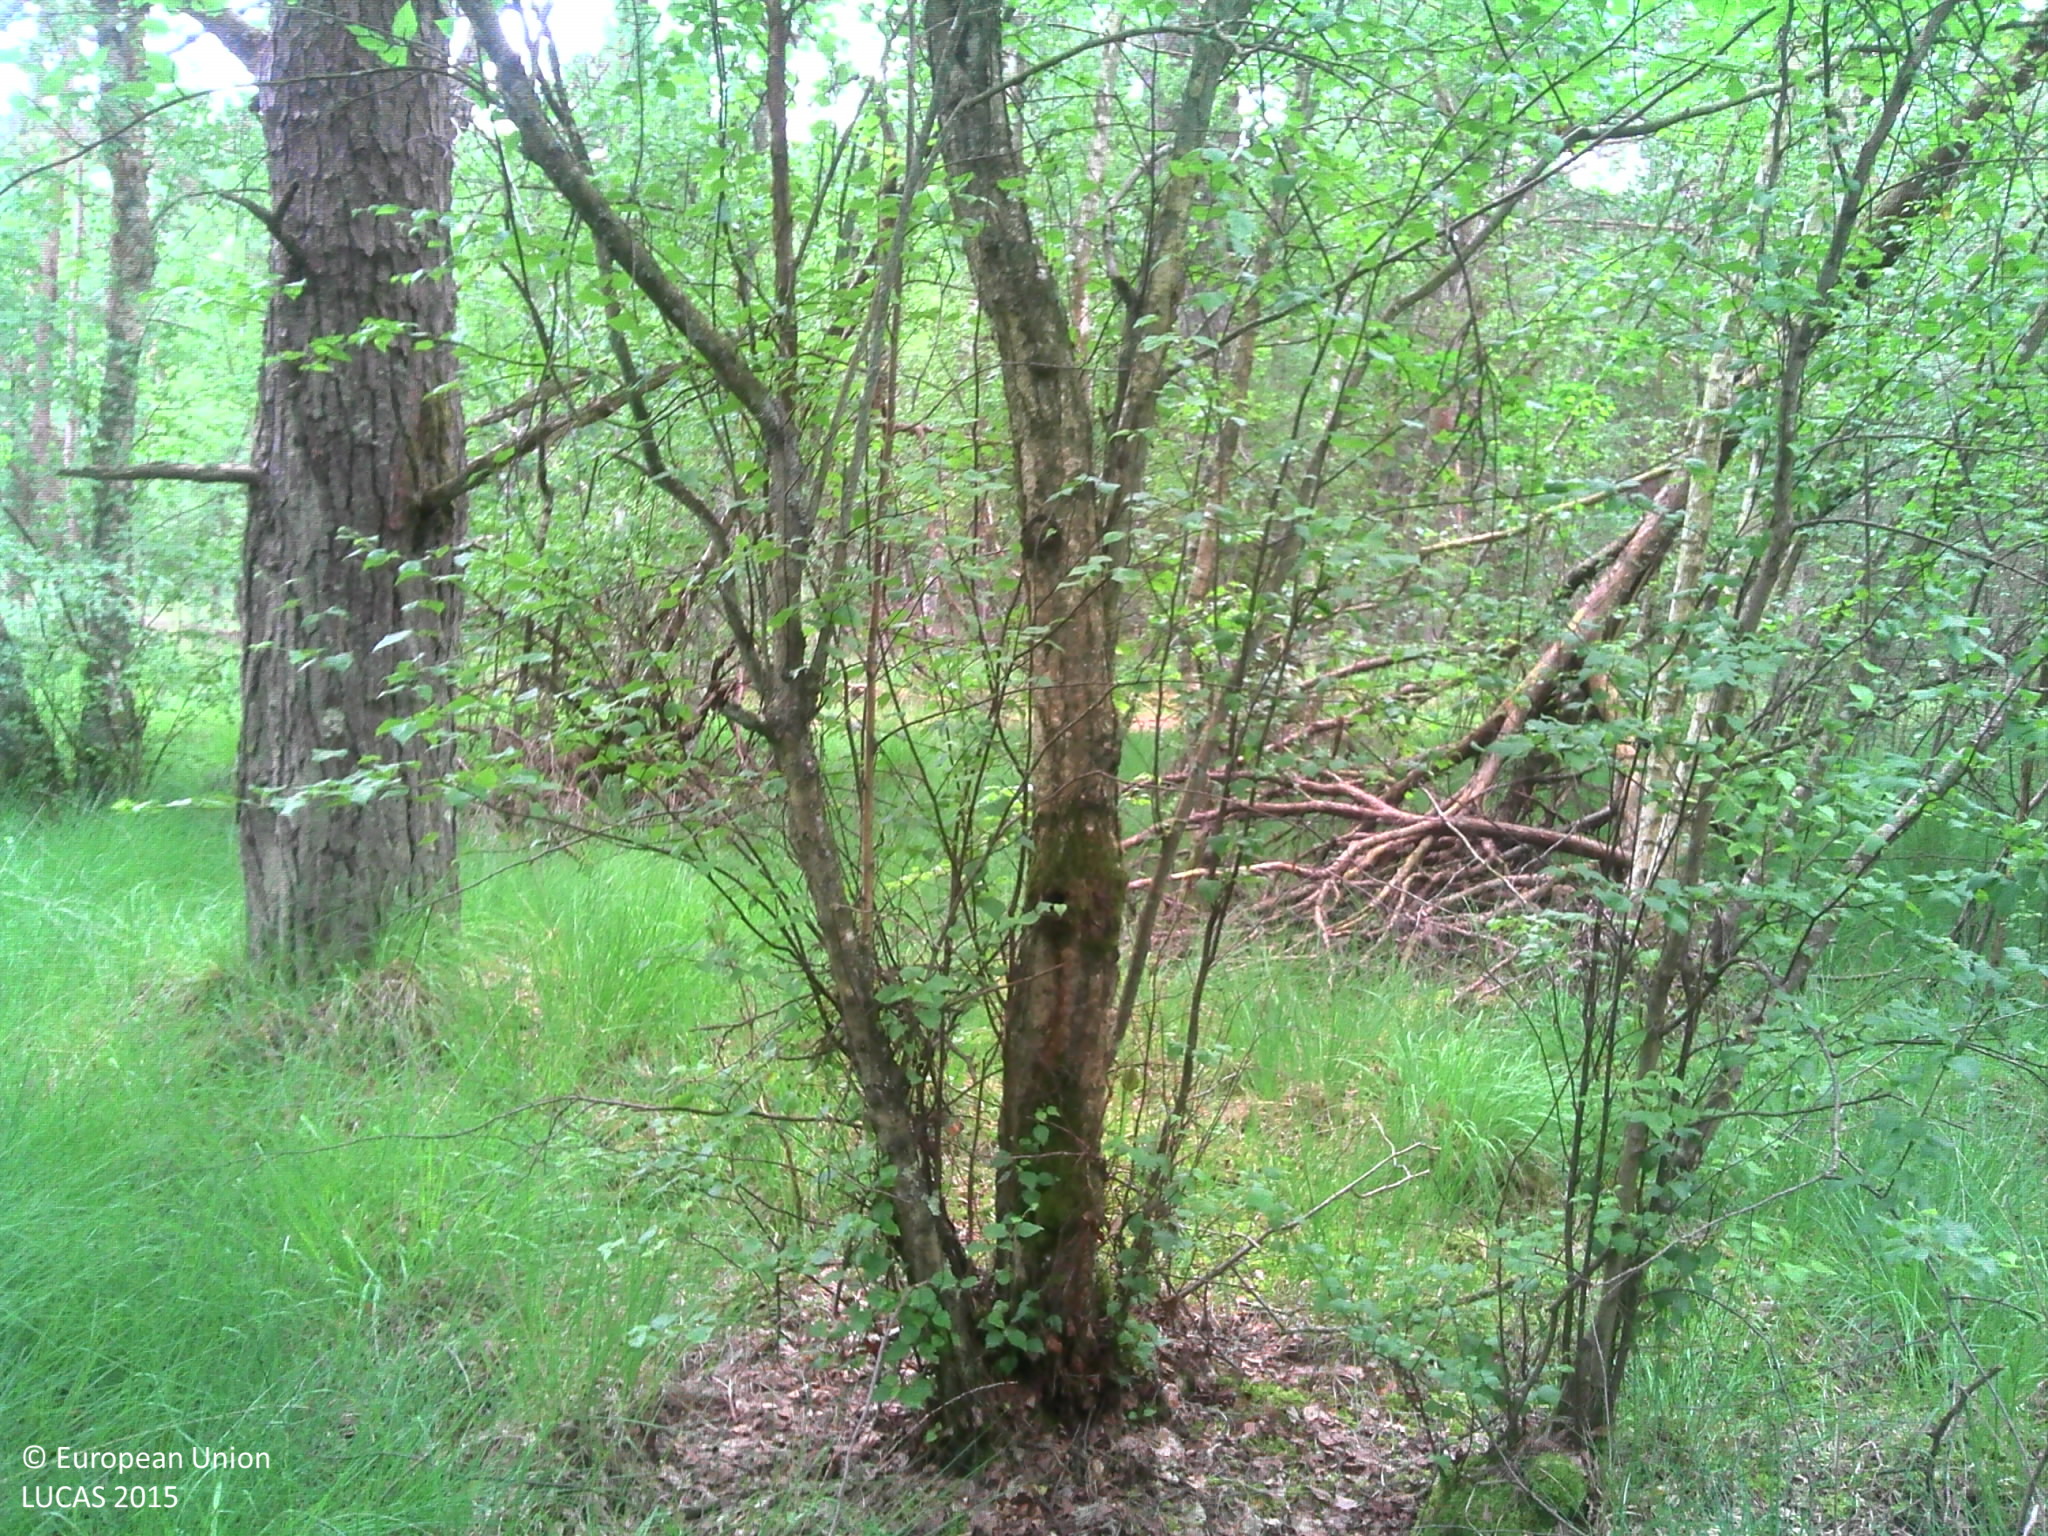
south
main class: Woodland
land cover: Pine dominated mixed woodland
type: thermophilous deciduous forest
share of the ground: > 75 %
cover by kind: herbaceous plants 60 %, coniferous forest trees 15 %, broadleaved forest trees 15 %, lichens and mosses 10 %
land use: Amenities, museums, leisure
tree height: > 5 m
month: June
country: FR
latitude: 47.5211
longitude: 2.0611
